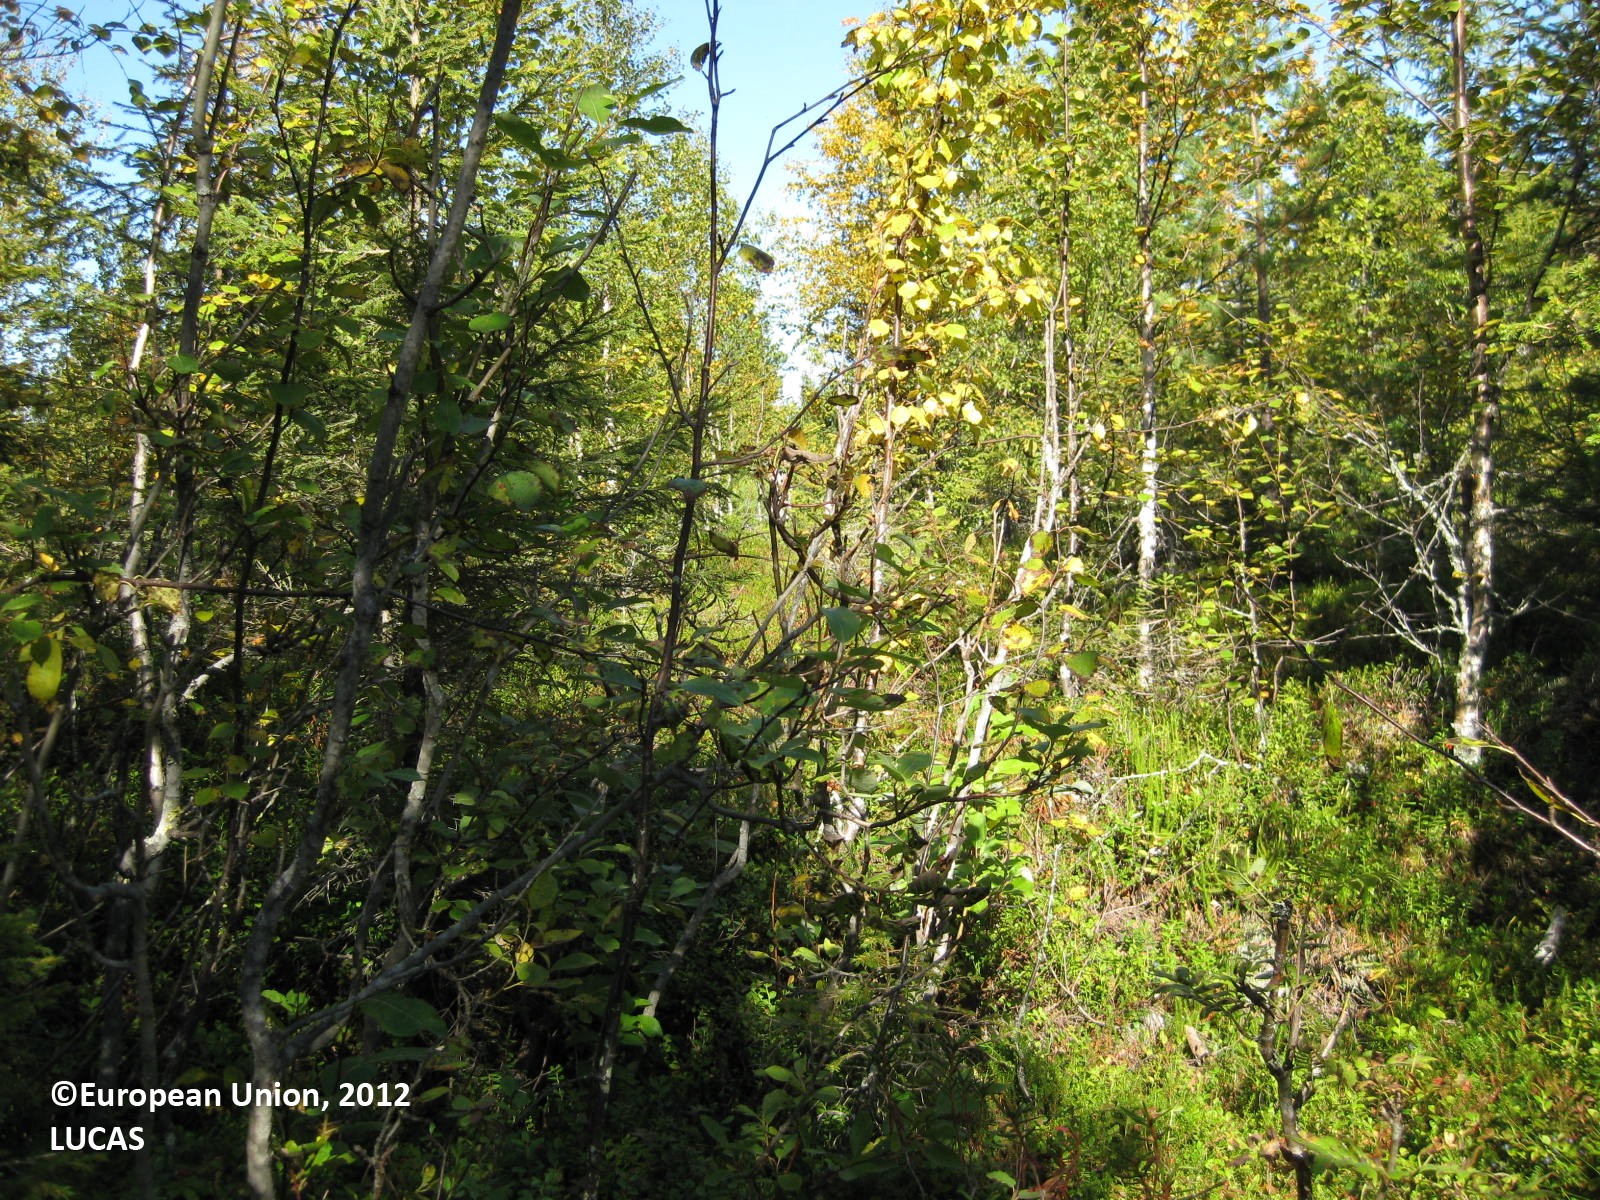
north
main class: Woodland
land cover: Other mixed woodland
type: boreal forest
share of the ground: > 75 %
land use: Forestry
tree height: > 5 m
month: August
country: FI
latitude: 66.0491
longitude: 29.7358
